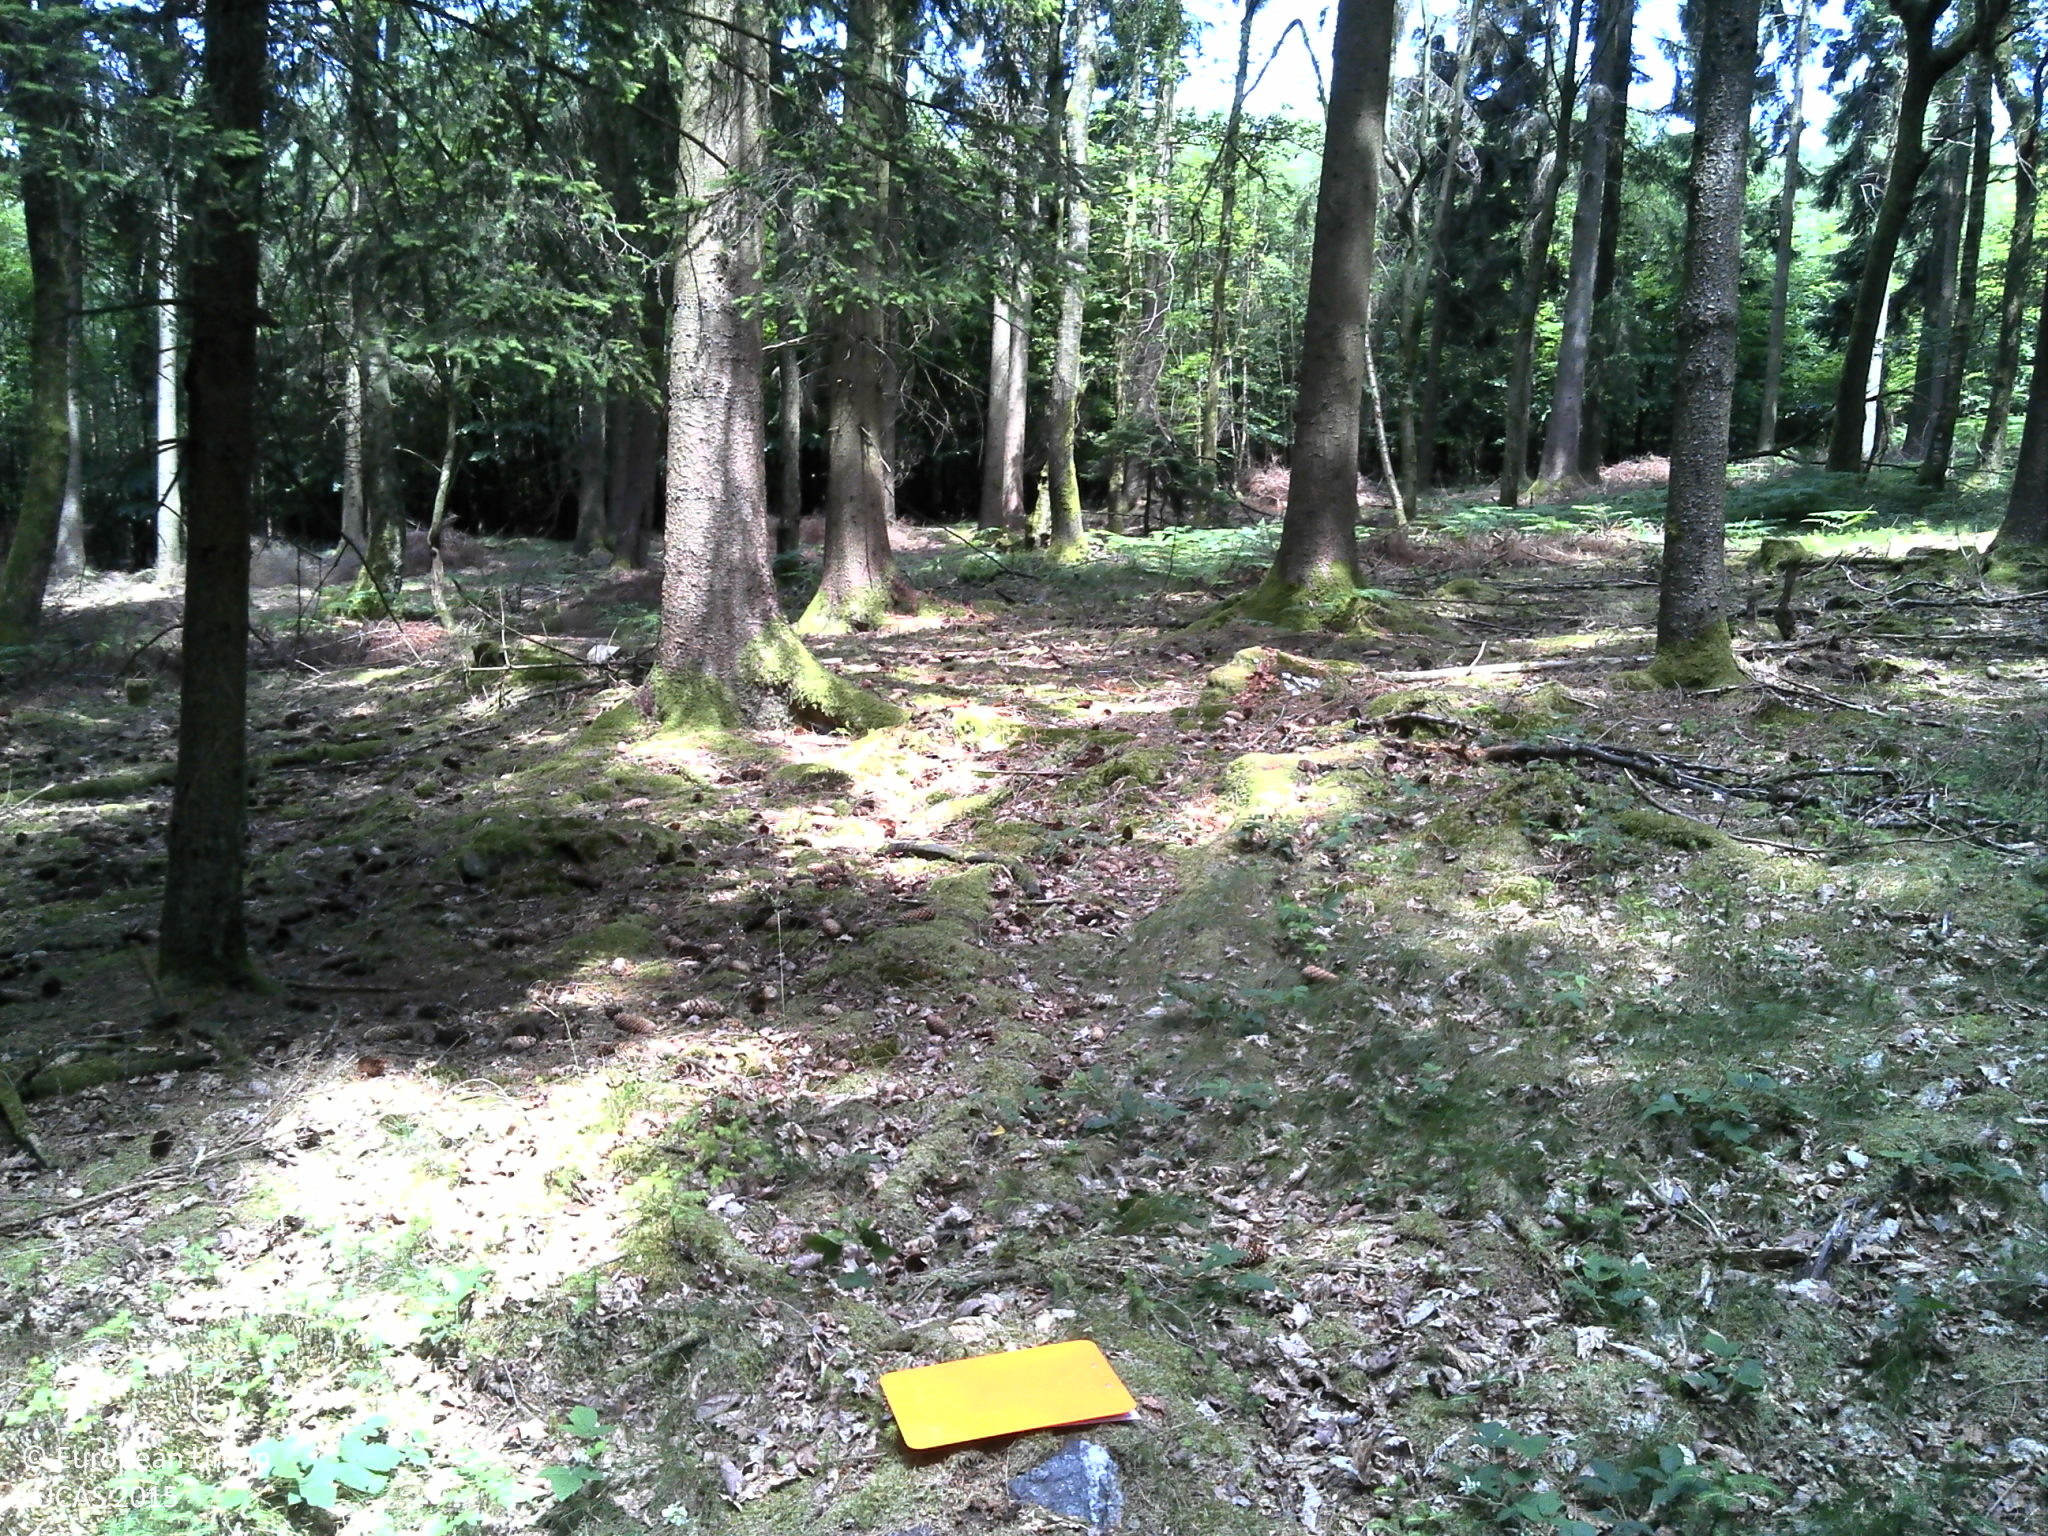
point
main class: Woodland
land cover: Spruce dominated mixed woodland
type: mountainous beech forest
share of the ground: 50 - 75 %
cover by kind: coniferous forest trees 50 %, broadleaved forest trees 25 %, herbaceous plants 10 %, lichens and mosses 10 %, consolidated bare surface 5 %
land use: Forestry
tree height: > 5 m
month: July
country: FR
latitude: 49.9177
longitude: 4.7182
